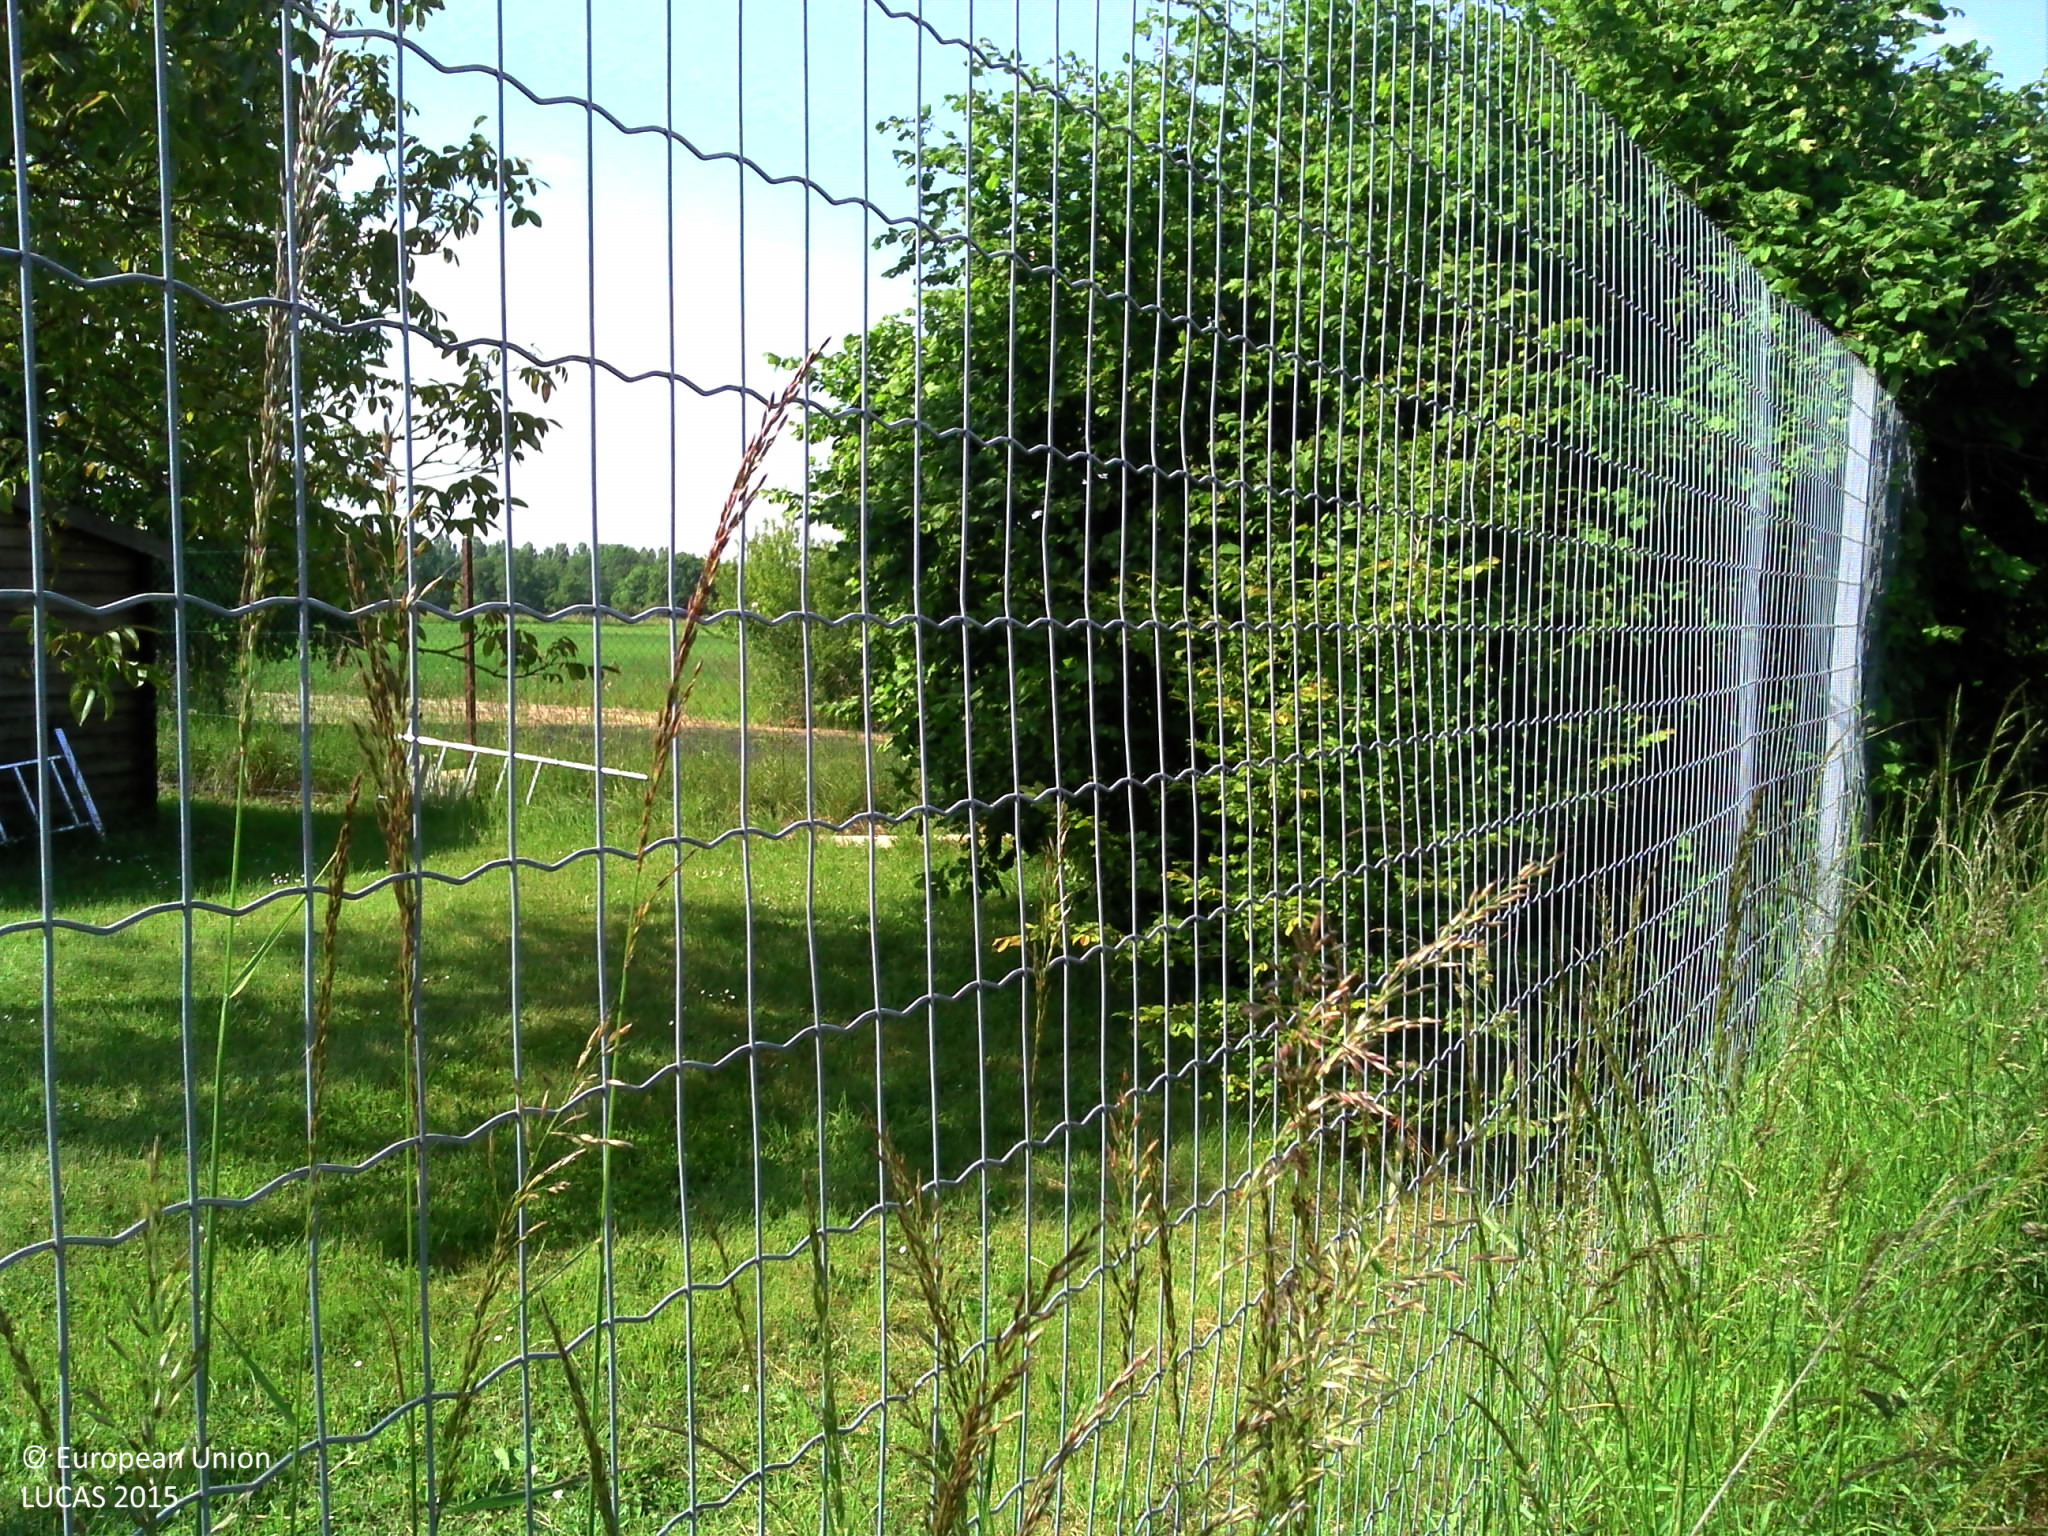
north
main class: Cropland
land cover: Rape and turnip rape
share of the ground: > 75 %
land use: Agriculture (excluding fallow land and kitchen gardens)
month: May
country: FR
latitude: 48.6610
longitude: 4.8251
